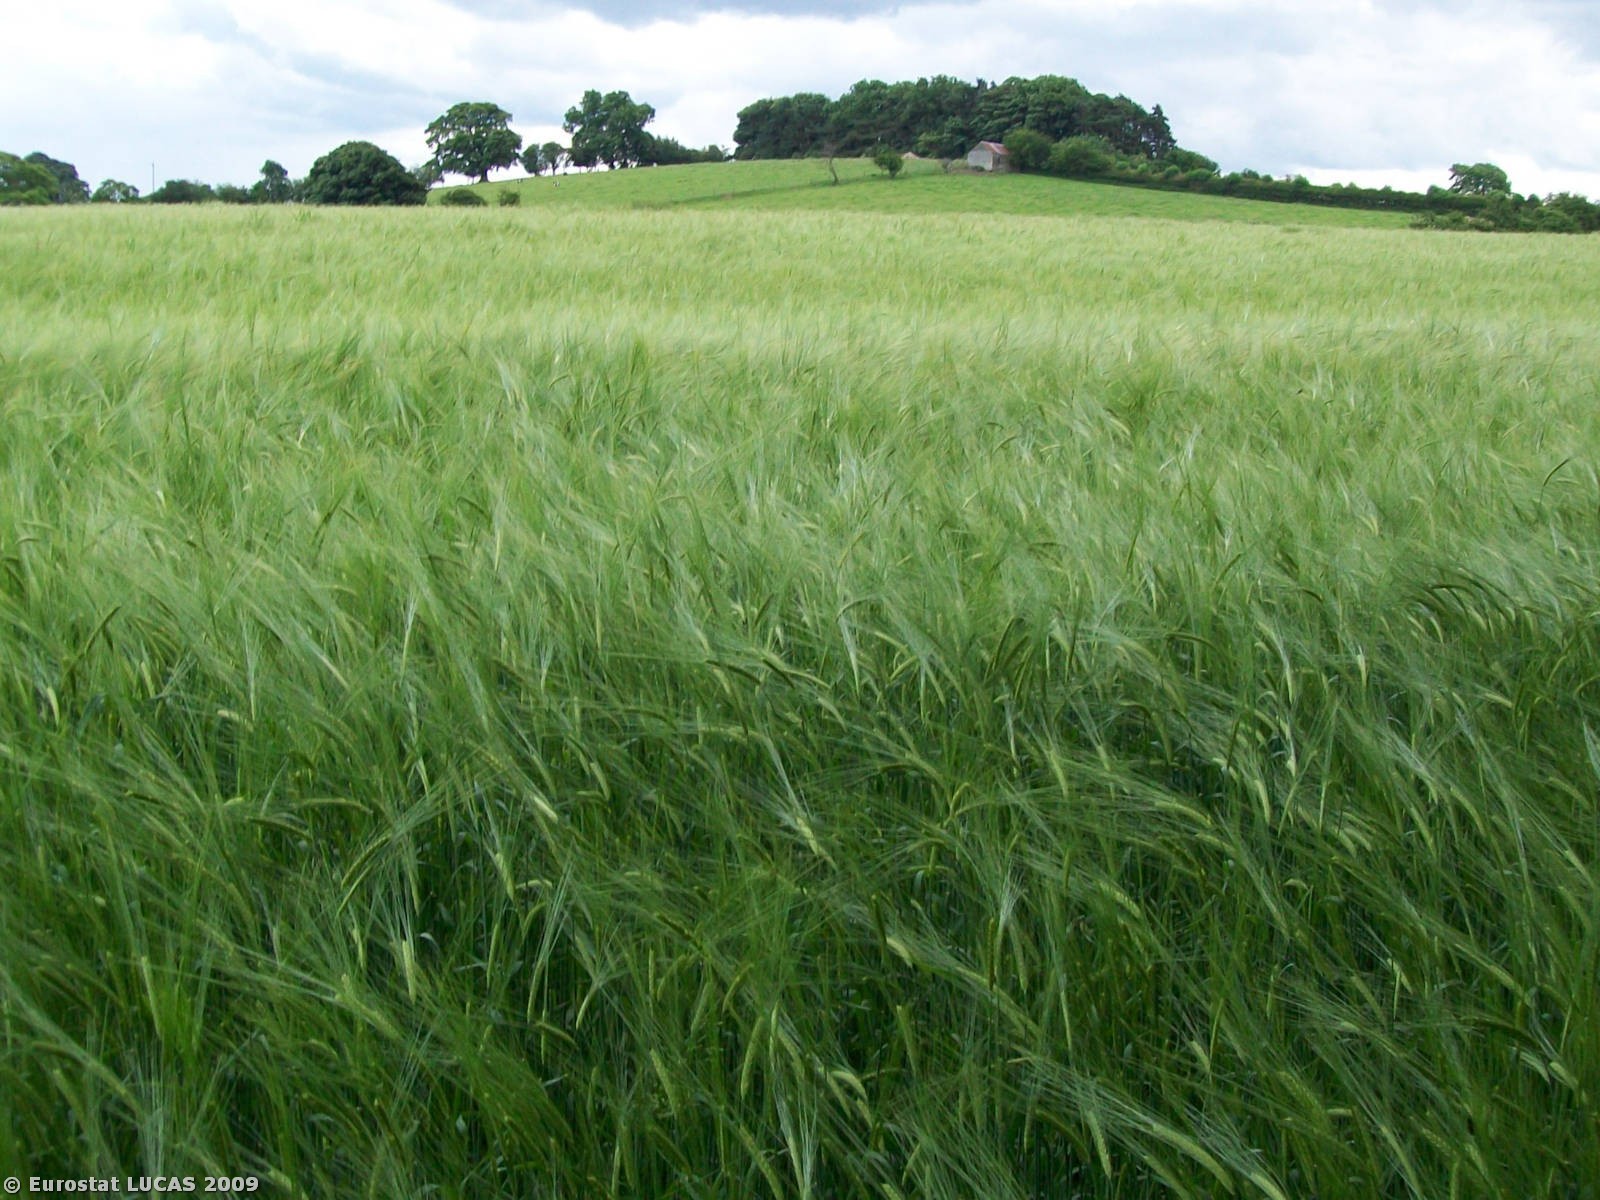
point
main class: Cropland
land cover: Barley
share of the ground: > 75 %
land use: Agriculture (excluding fallow land and kitchen gardens)
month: July
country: GB
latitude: 54.5069
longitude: -1.8684
